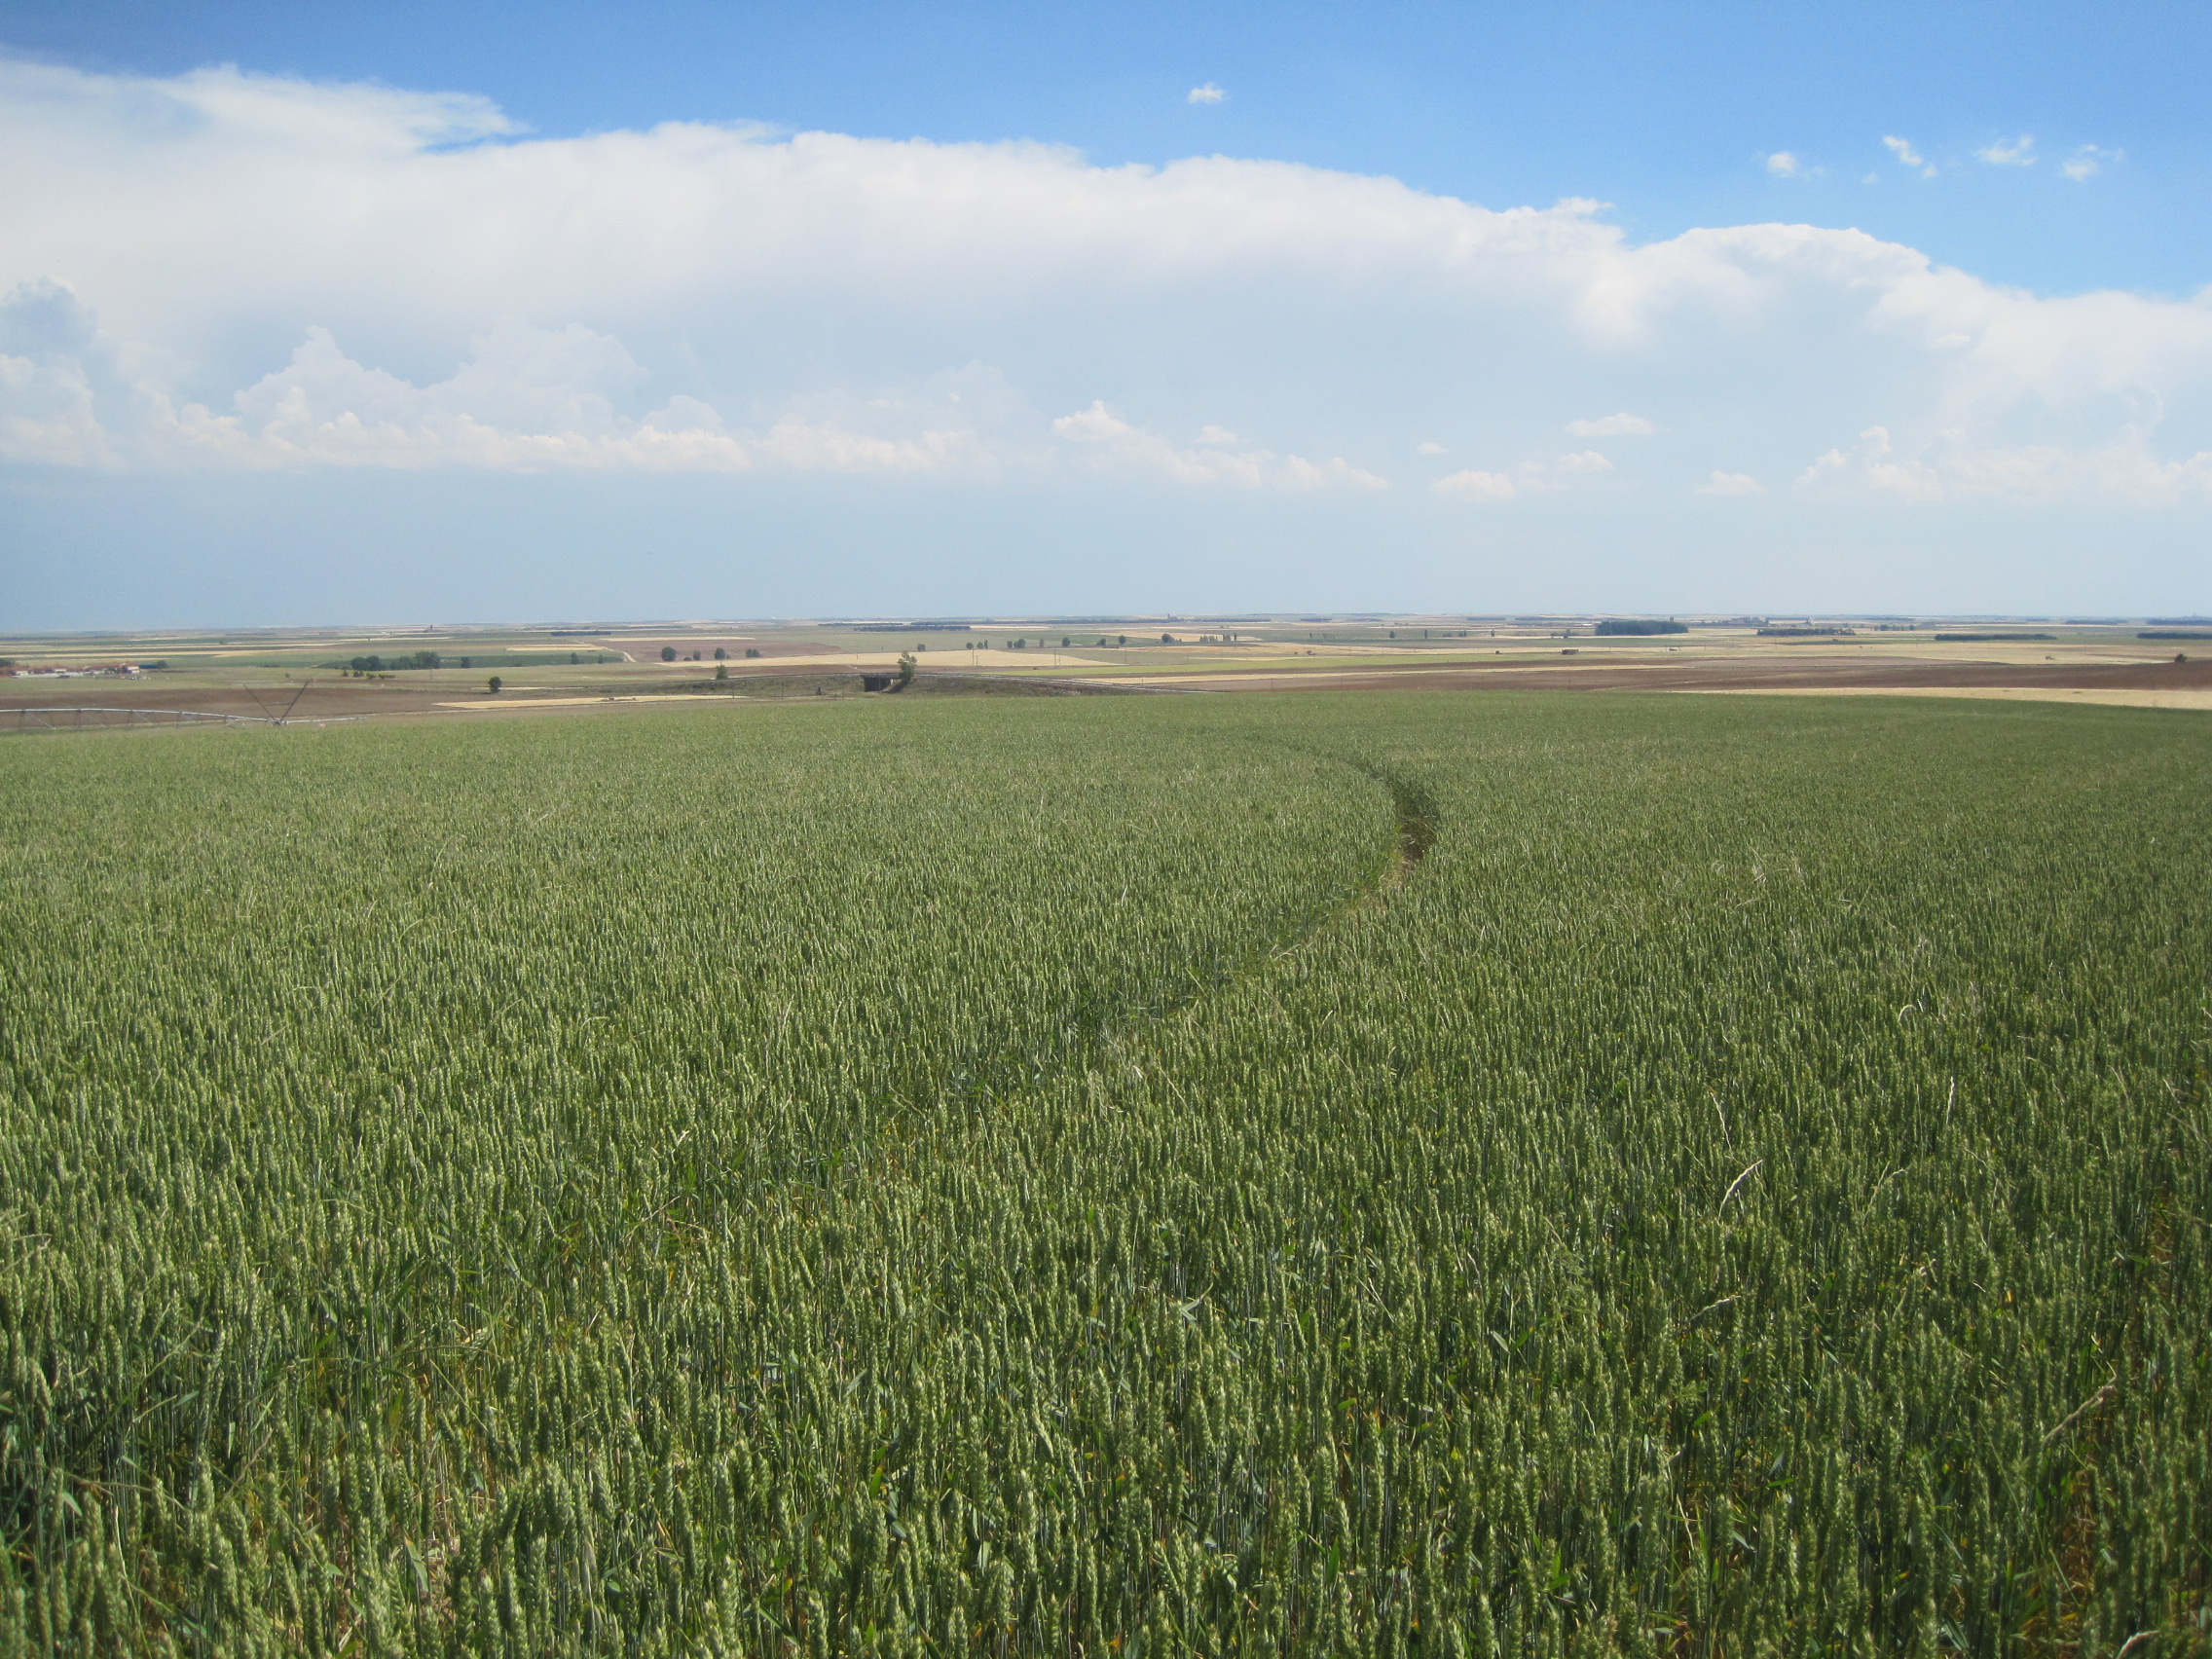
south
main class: Cropland
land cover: Common wheat
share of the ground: > 75 %
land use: Agriculture (excluding fallow land and kitchen gardens)
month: May
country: ES
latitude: 41.3219
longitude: -5.0397
